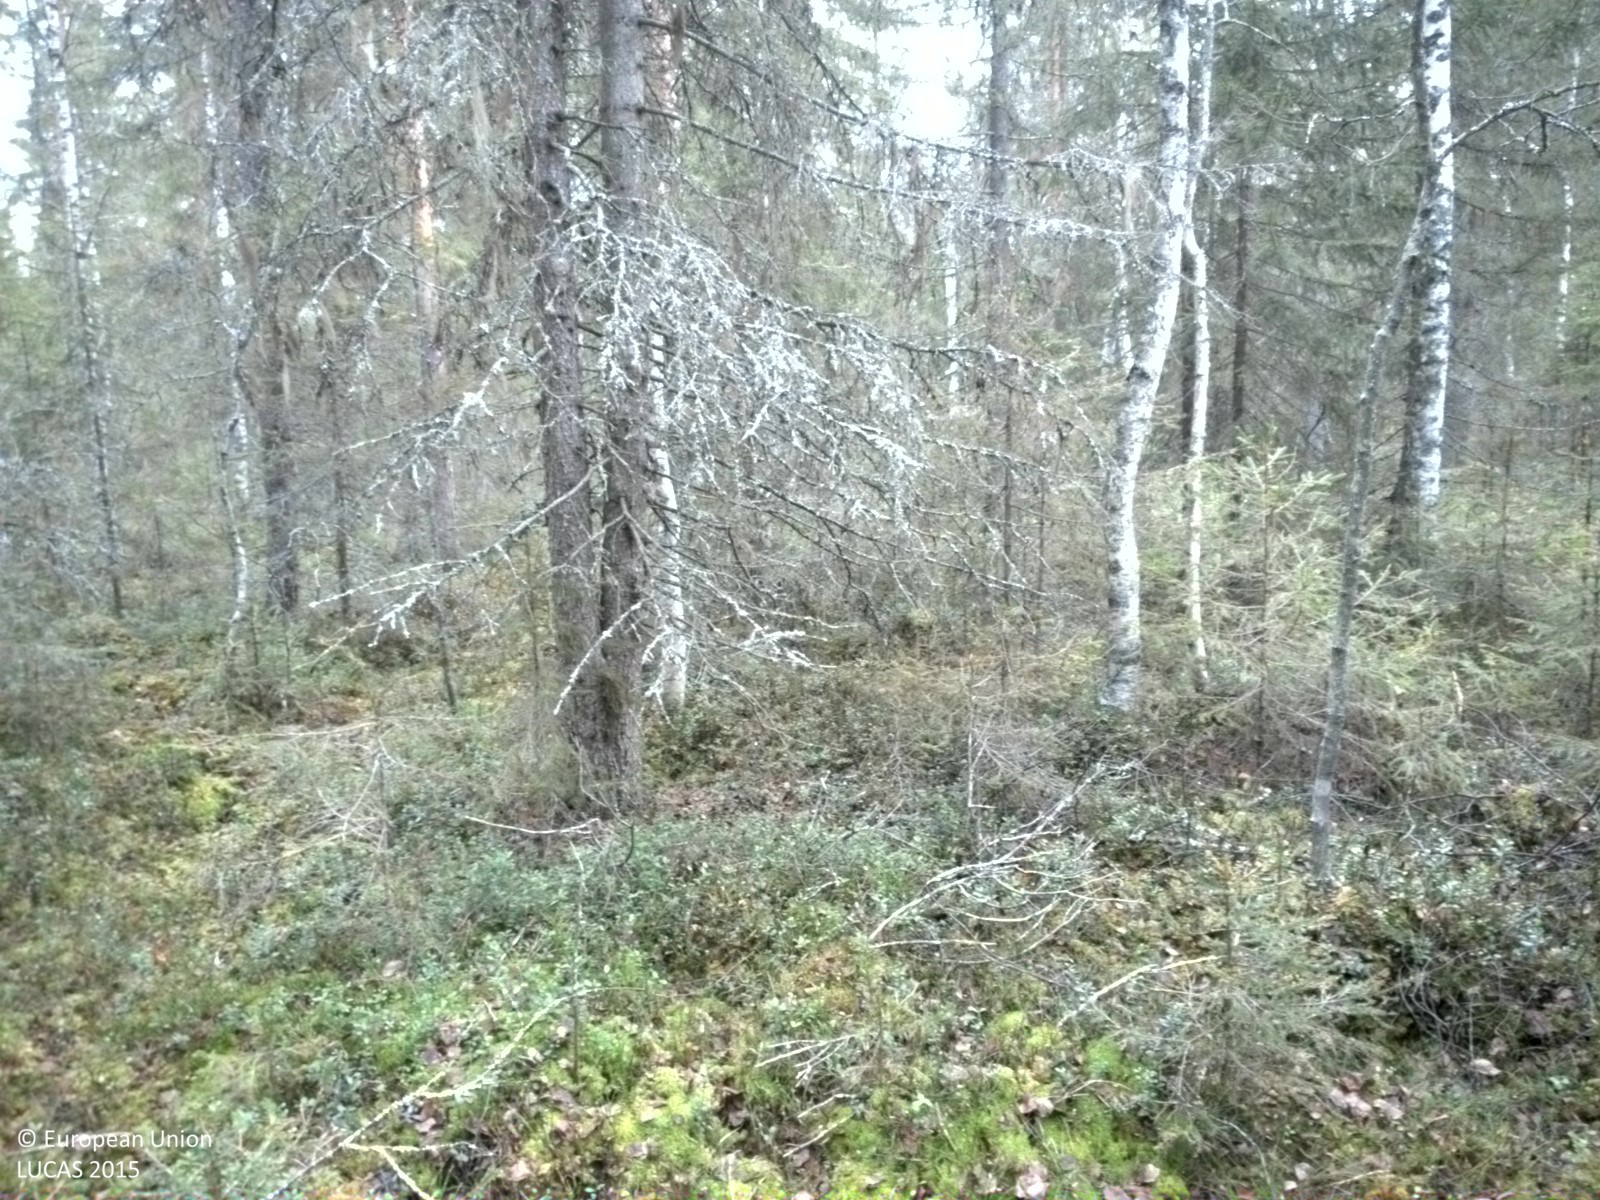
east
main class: Woodland
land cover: Spruce dominated mixed woodland
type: boreal forest
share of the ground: 50 - 75 %
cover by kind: coniferous forest trees 40 %, shrubs 40 %, broadleaved forest trees 15 %, lichens and mosses 5 %
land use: Forestry
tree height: > 5 m
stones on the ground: < 10 %
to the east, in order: Spruce dominated mixed woodland; Other mixed woodland; Groves; Ditches and canals; Temporary grasslands
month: October
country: SE
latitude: 65.6577
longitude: 21.0358
